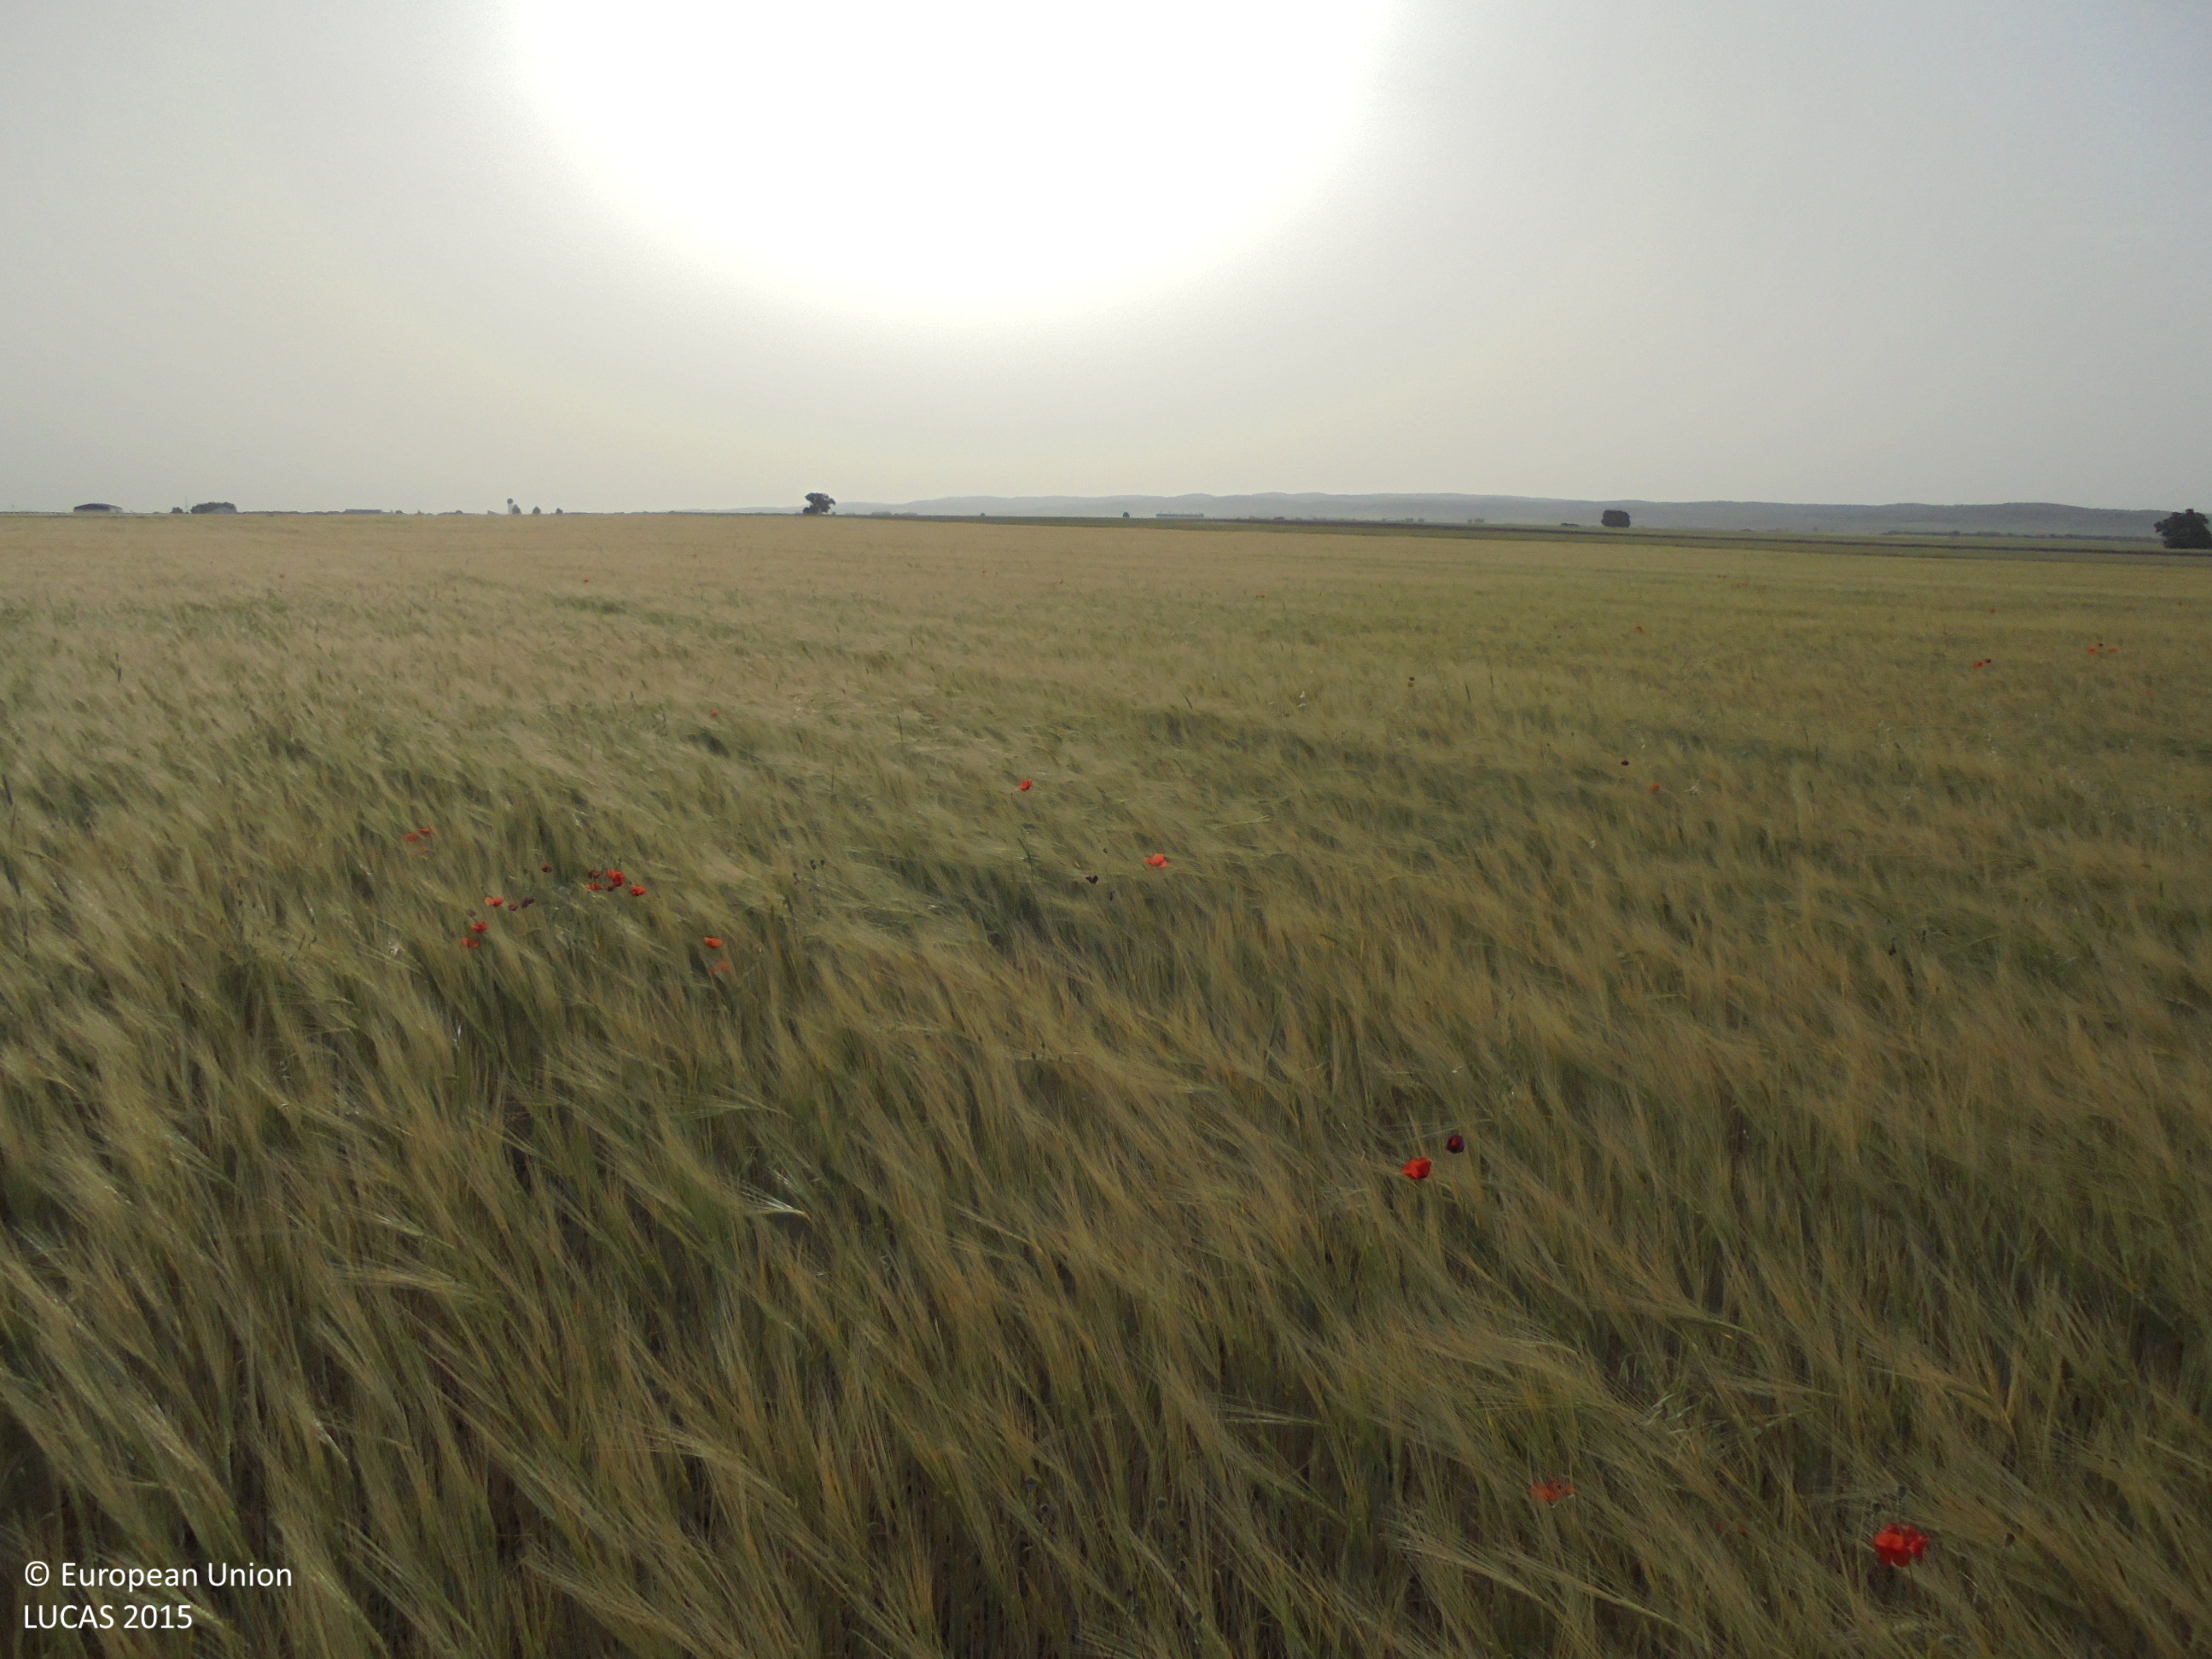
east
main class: Cropland
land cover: Barley
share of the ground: > 75 %
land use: Agriculture (excluding fallow land and kitchen gardens)
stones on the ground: 25 - 50 %
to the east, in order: Barley; Grass margins; Oats
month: May
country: ES
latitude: 39.0318
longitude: -1.7251
